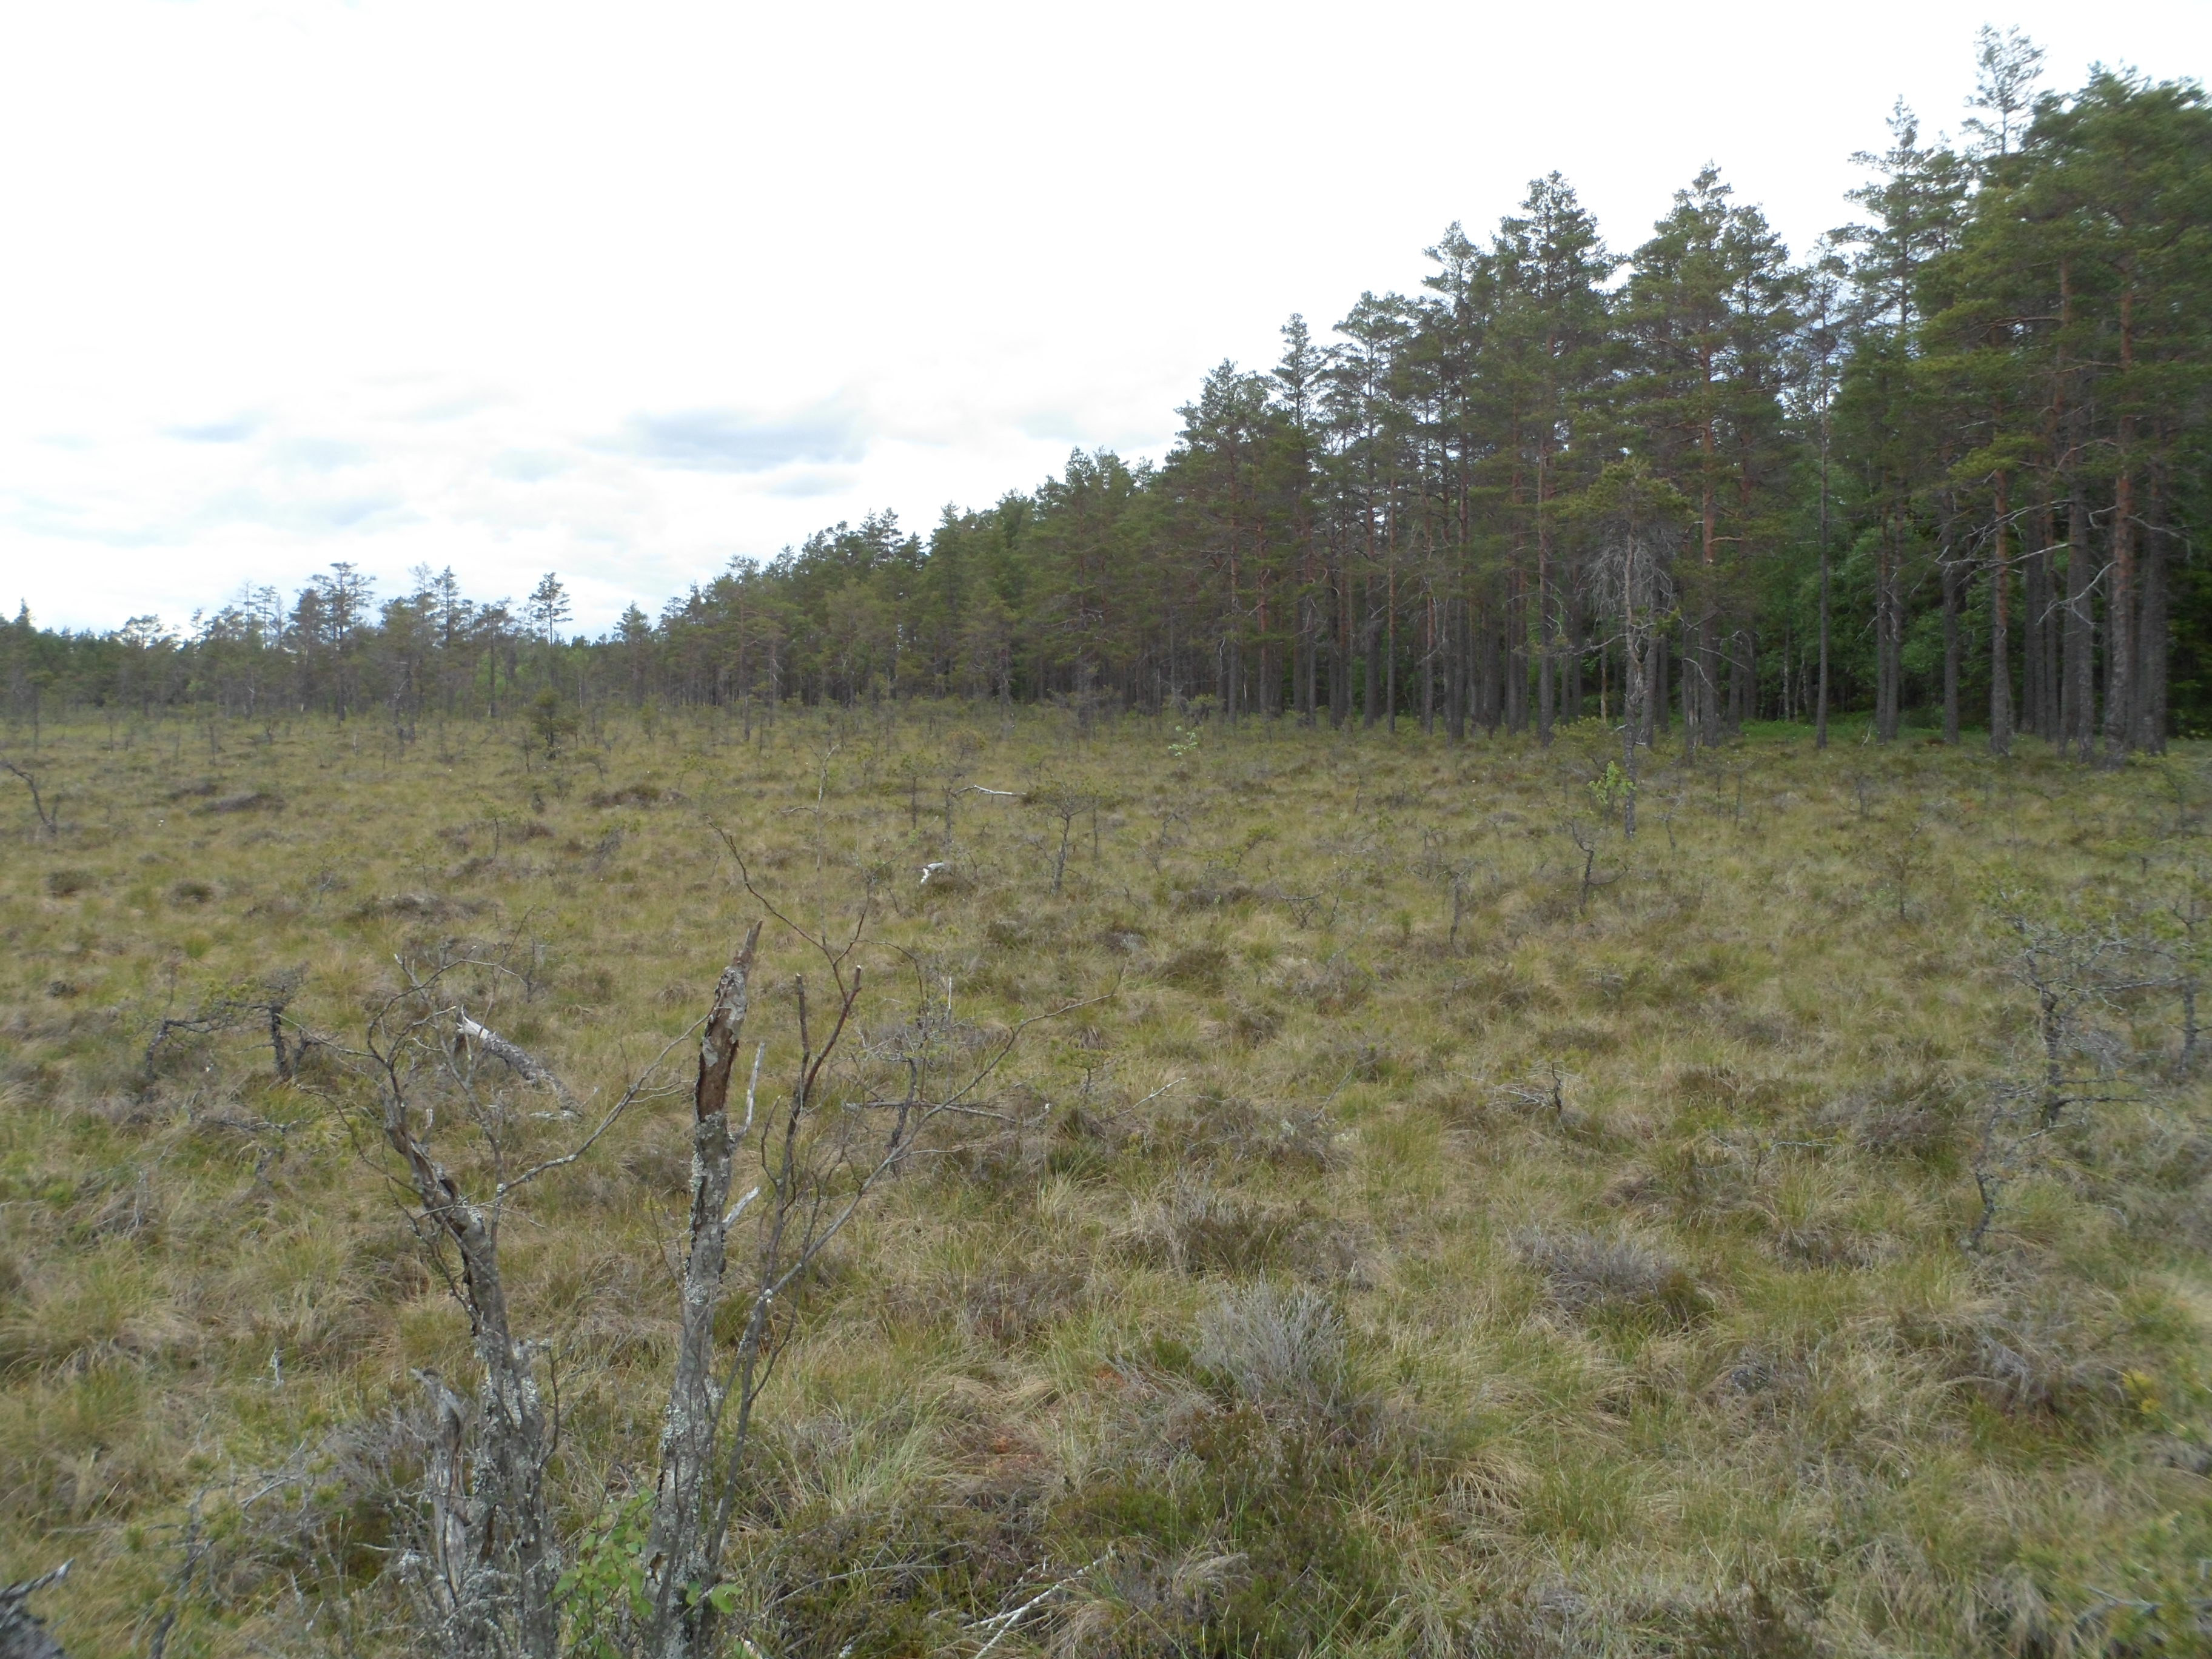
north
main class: Woodland
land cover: Pine dominated coniferous woodland
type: boreal forest
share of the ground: 10 - 25 %
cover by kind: herbaceous plants 40 %, lichens and mosses 35 %, coniferous forest trees 15 %, shrubs 10 %
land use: Amenities, museums, leisure
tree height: < 5 m
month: June
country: SE
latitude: 57.3908
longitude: 14.4048
